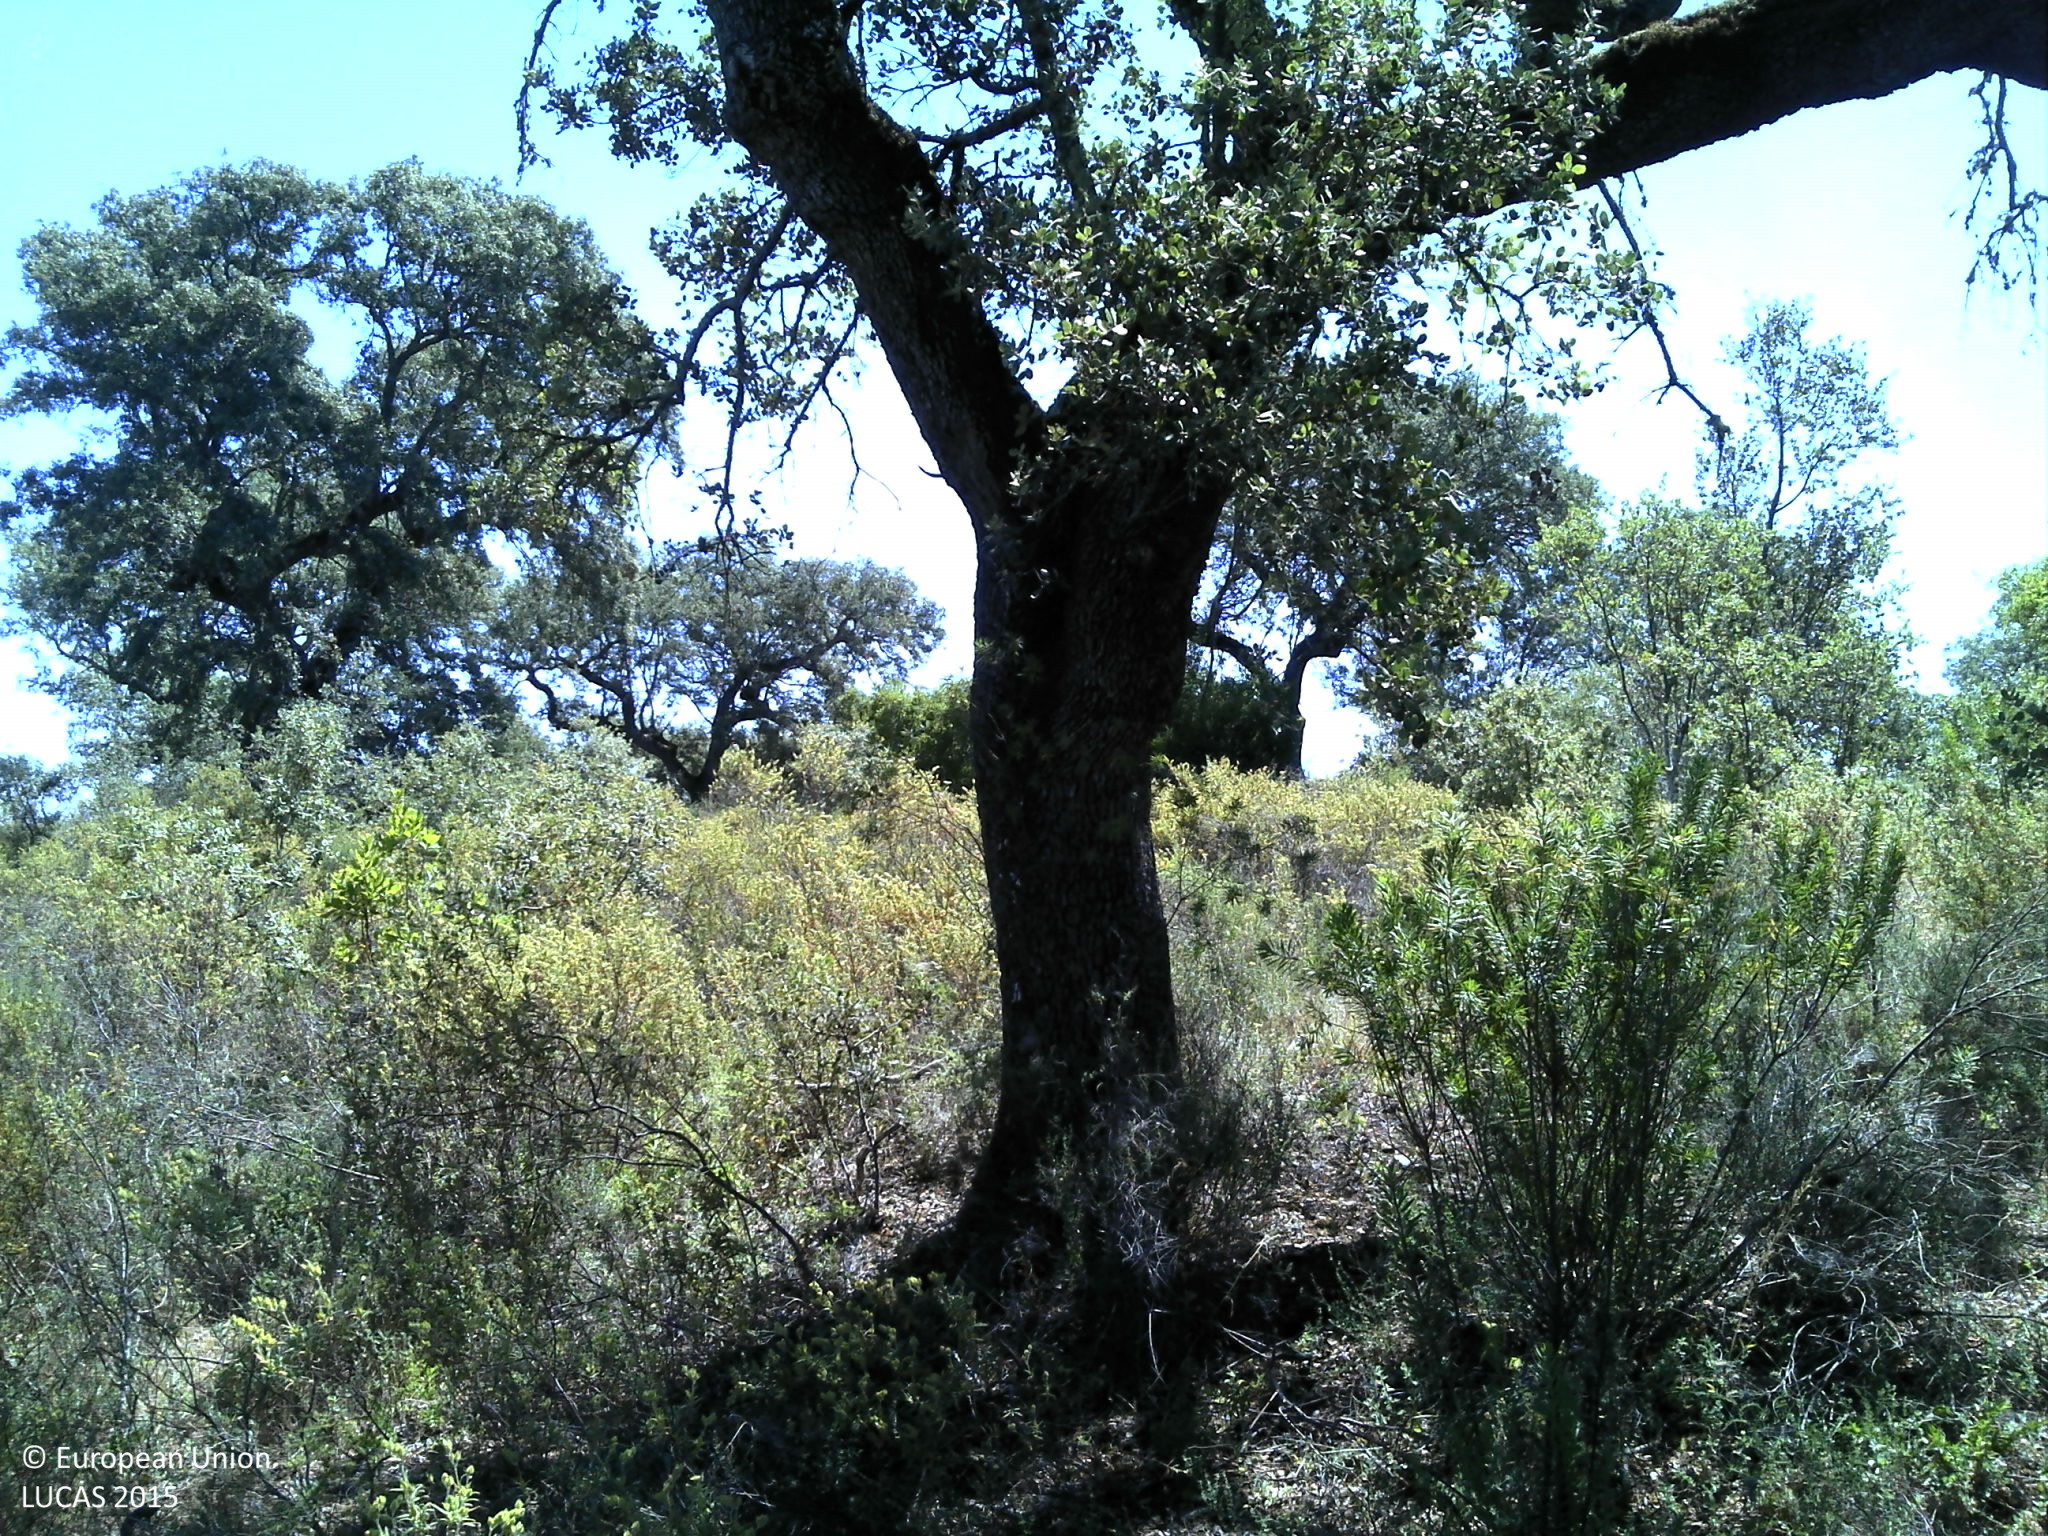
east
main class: Woodland
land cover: Broadleaved woodland
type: broadleaved evergreen forest
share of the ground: > 75 %
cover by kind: broadleaved forest trees 80 %, shrubs 20 %
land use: Forestry
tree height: > 5 m
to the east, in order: Broadleaved woodland; Fences; Broadleaved woodland
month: May
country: PT
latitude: 38.8445
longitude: -8.1038
